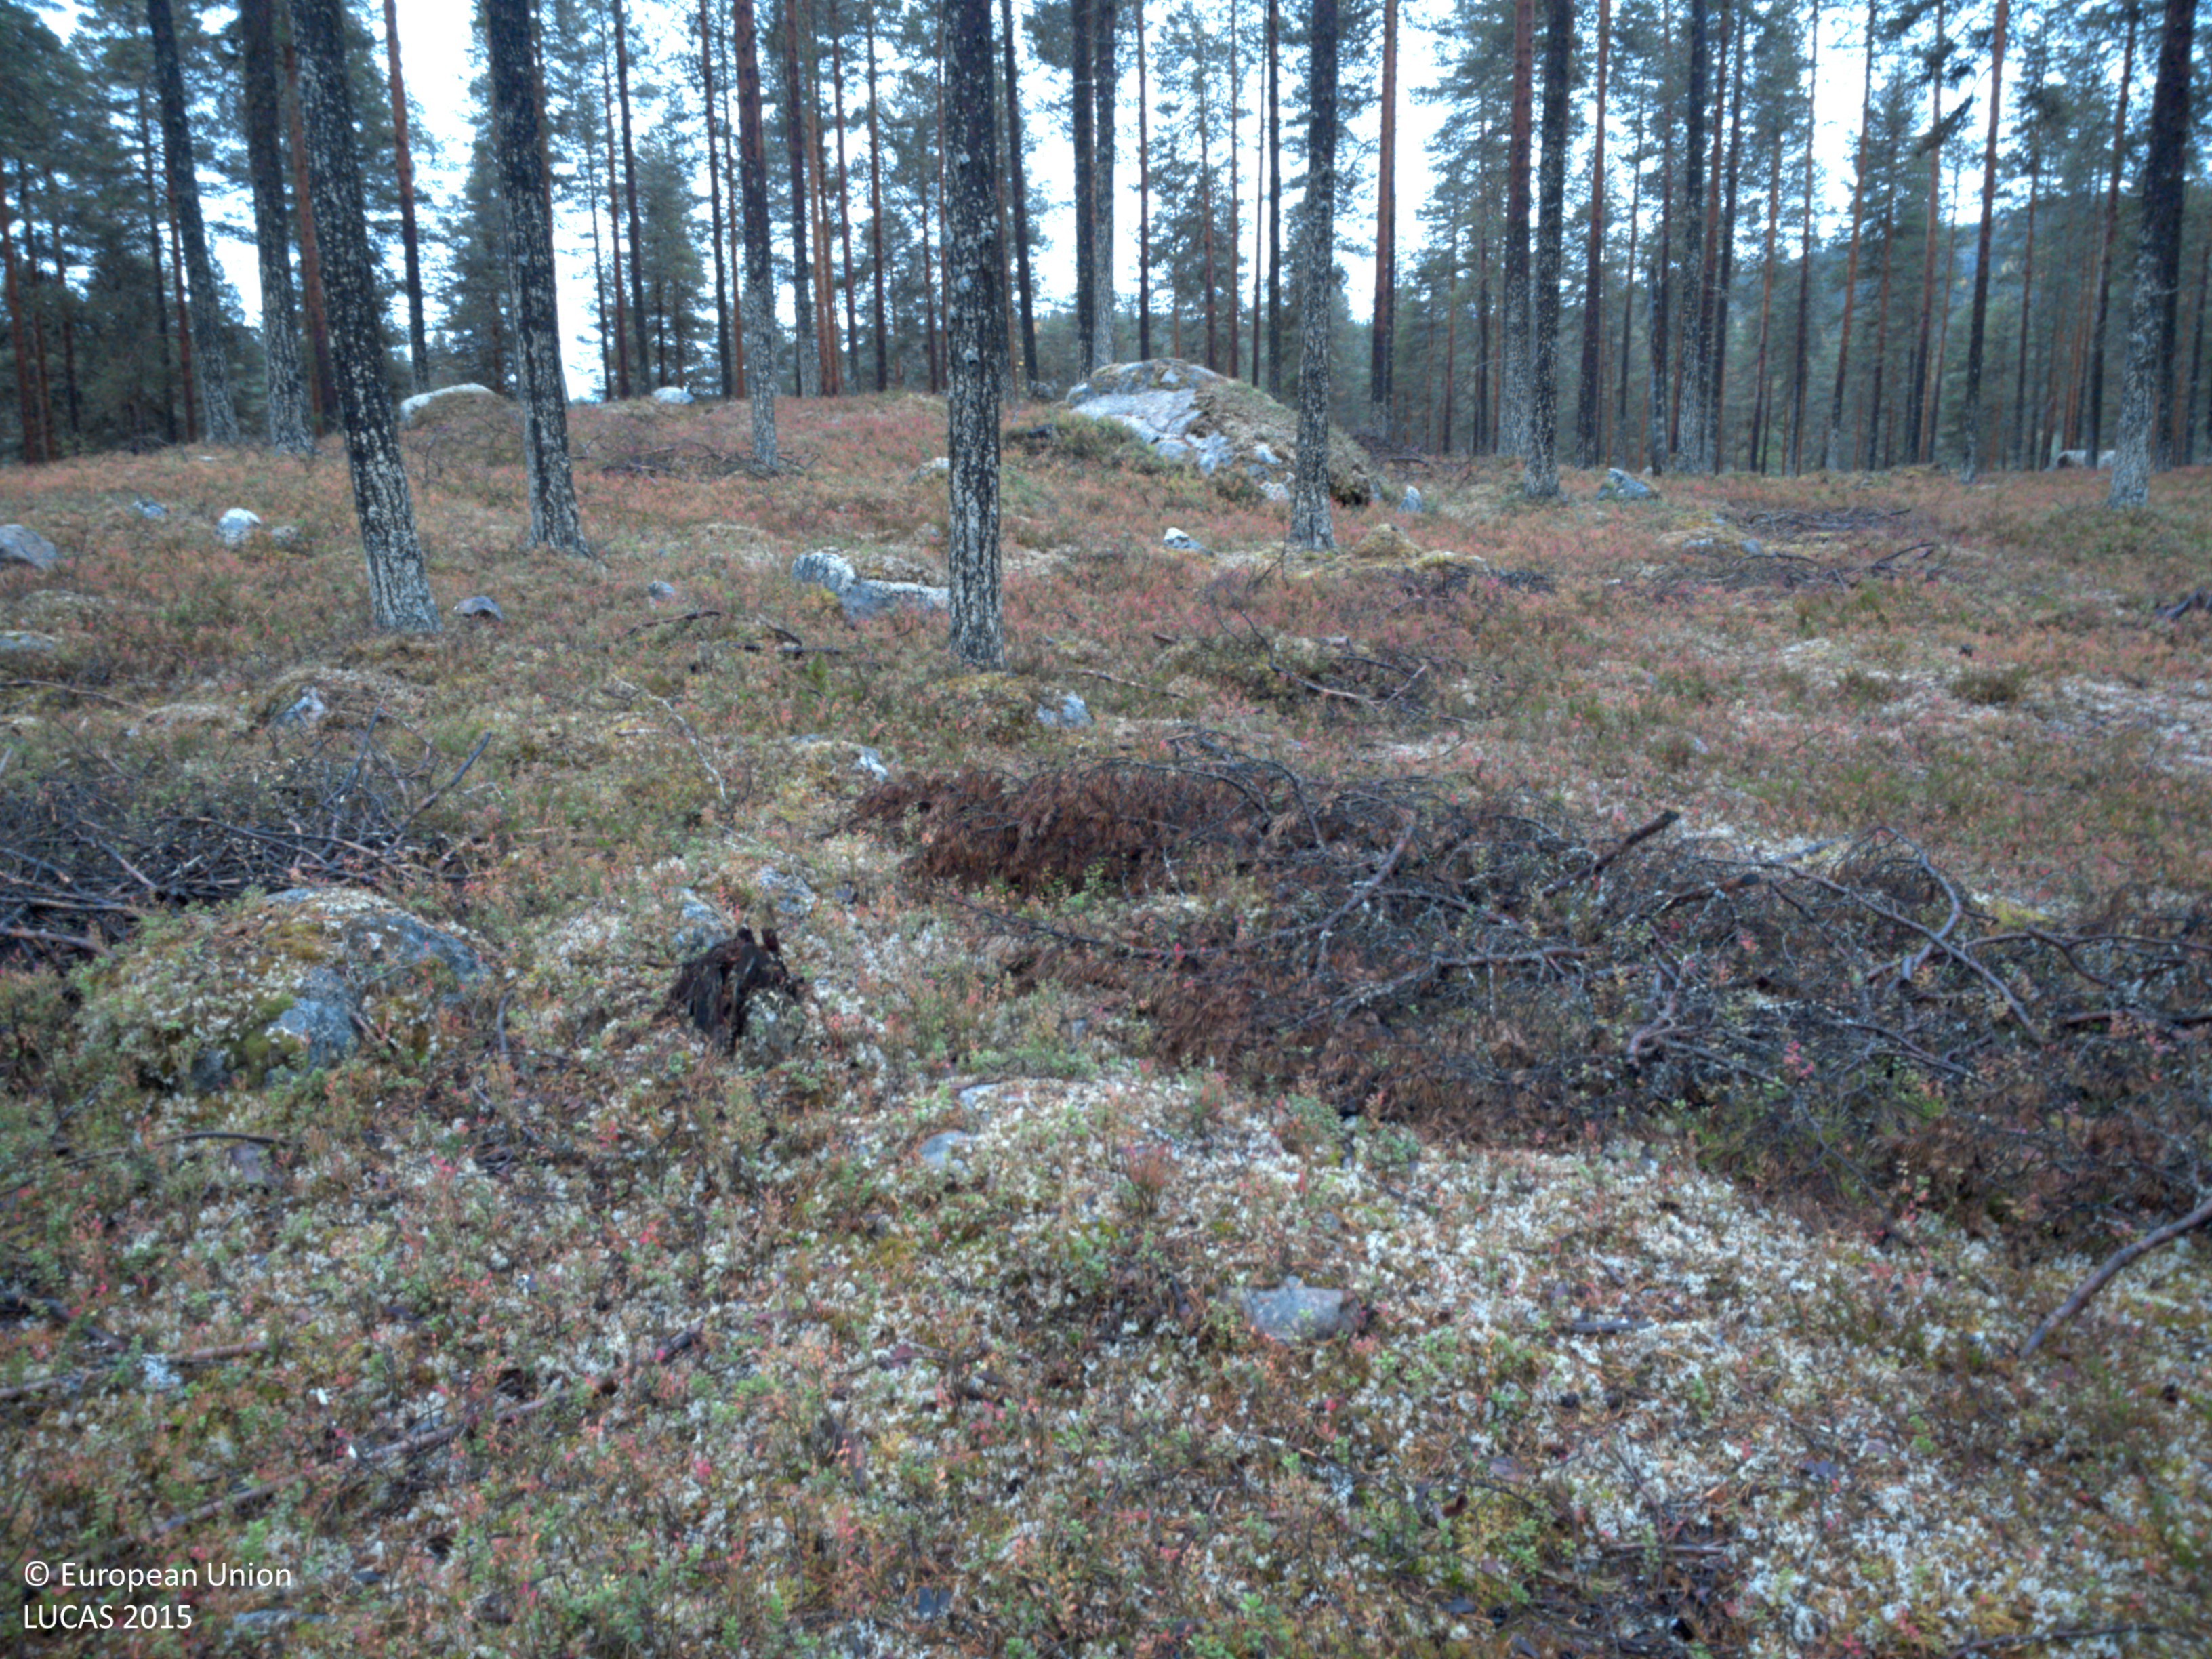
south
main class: Woodland
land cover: Pine dominated coniferous woodland
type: boreal forest
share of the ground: 25 - 50 %
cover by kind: coniferous forest trees 50 %, shrubs 35 %, lichens and mosses 15 %
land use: Forestry
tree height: > 5 m
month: September
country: SE
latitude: 64.9228
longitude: 19.0377
